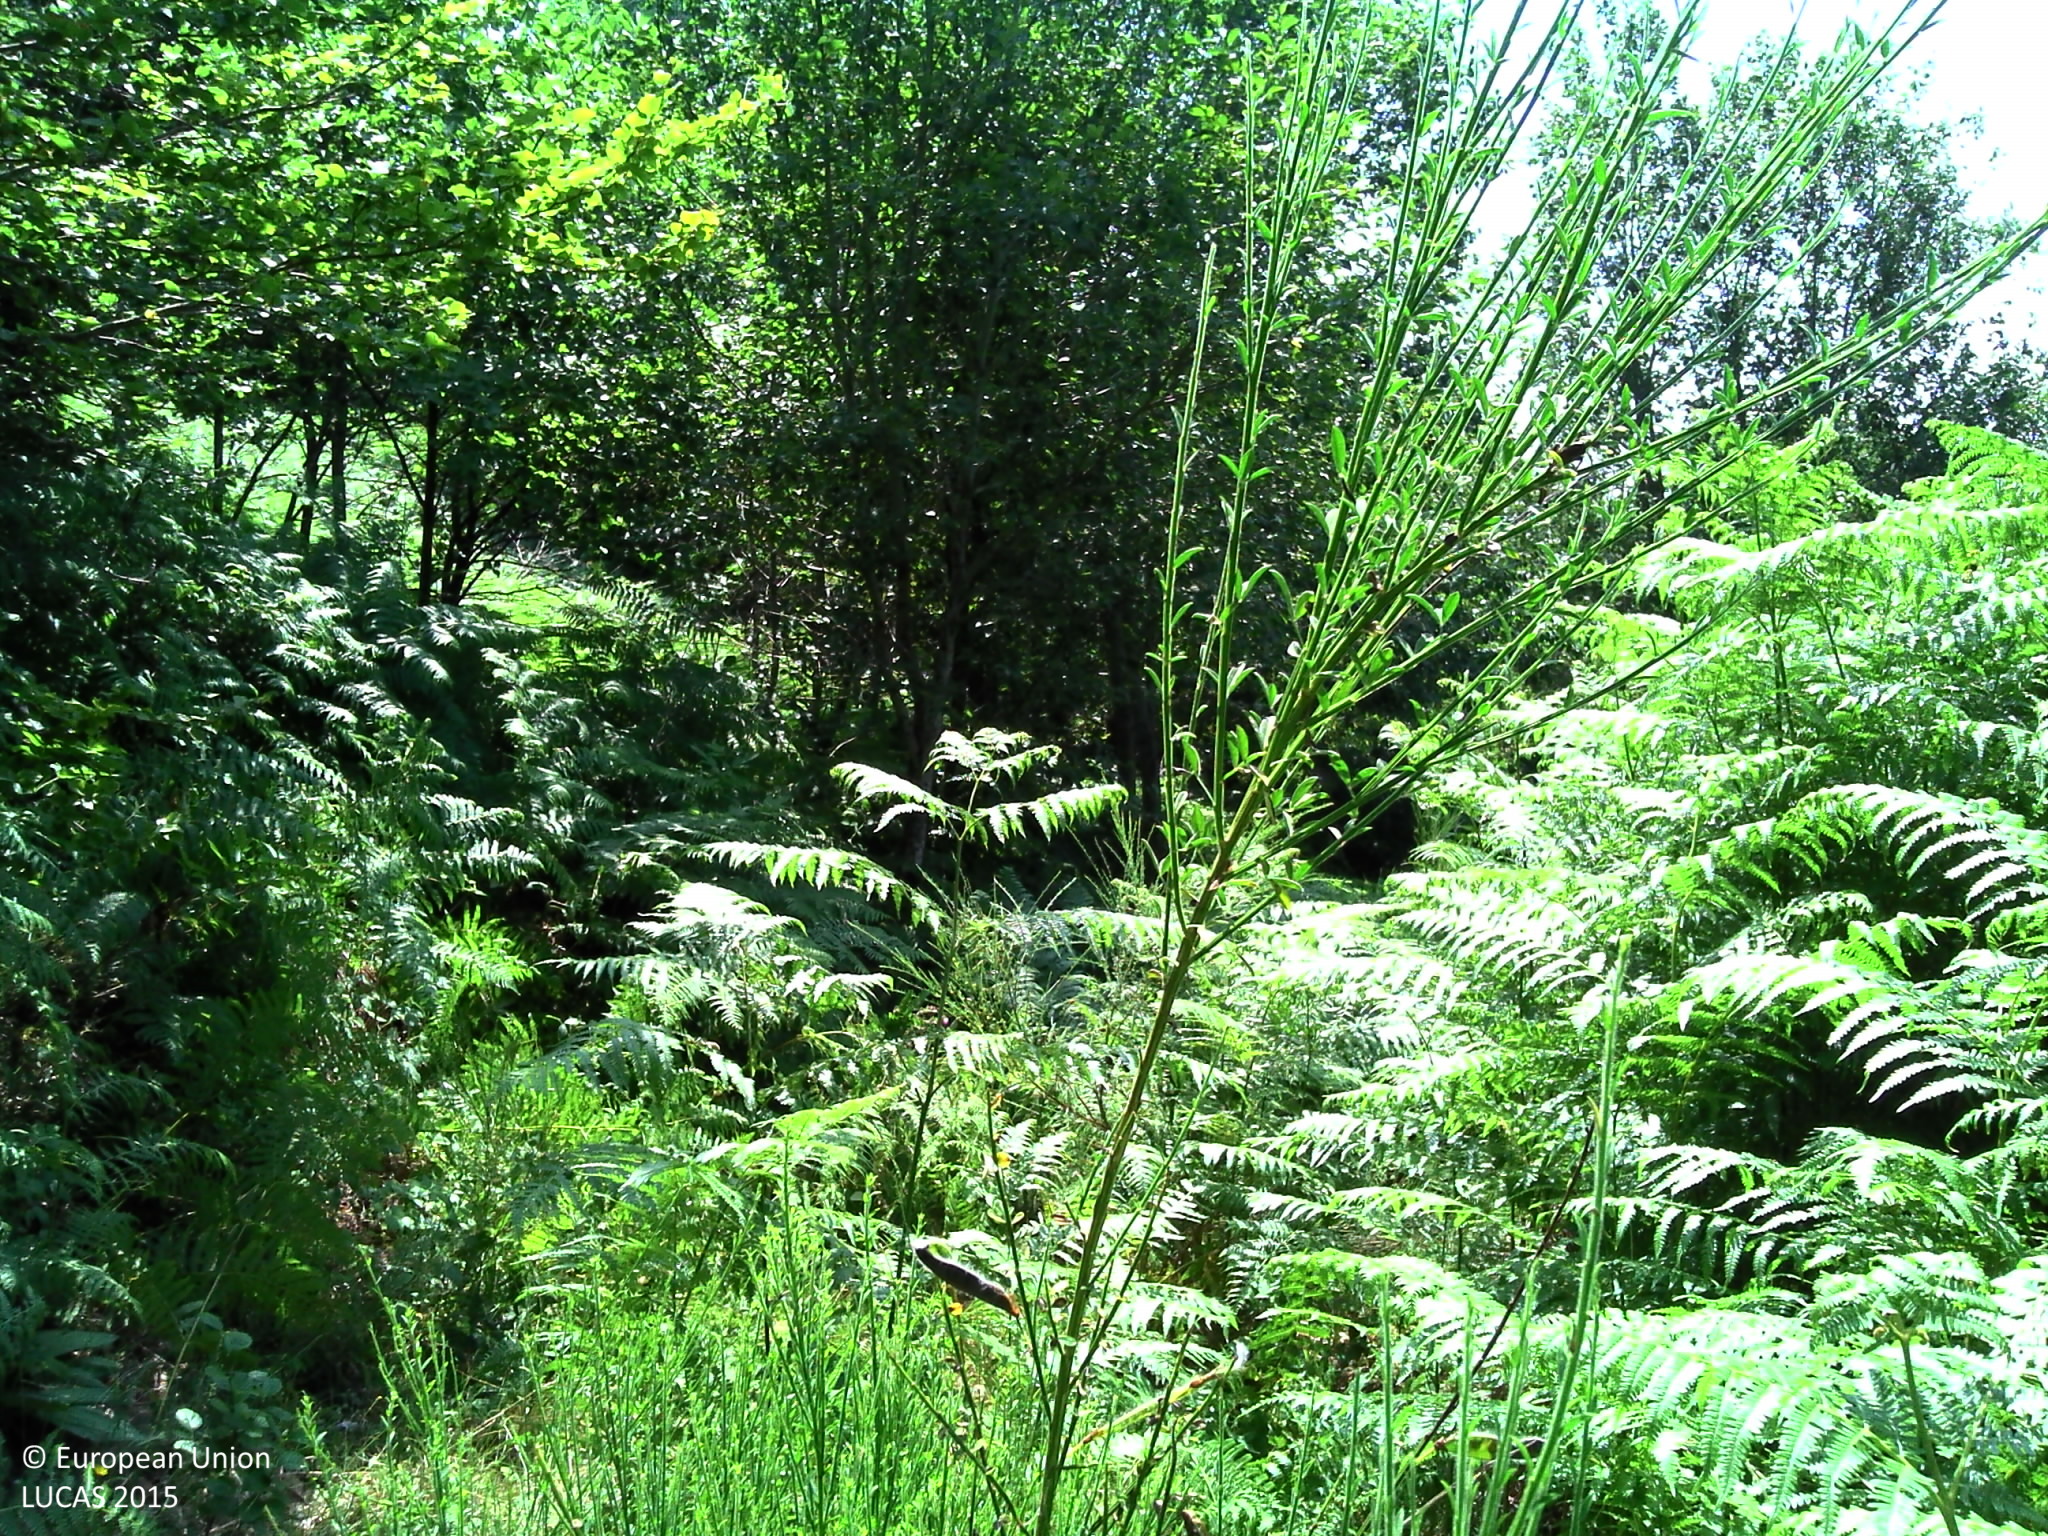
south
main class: Woodland
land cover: Broadleaved woodland
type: beech forest
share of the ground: > 75 %
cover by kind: broadleaved forest trees 80 %, herbaceous plants 20 %
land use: Forestry
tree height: > 5 m
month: July
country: FR
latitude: 44.5333
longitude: 3.0450
